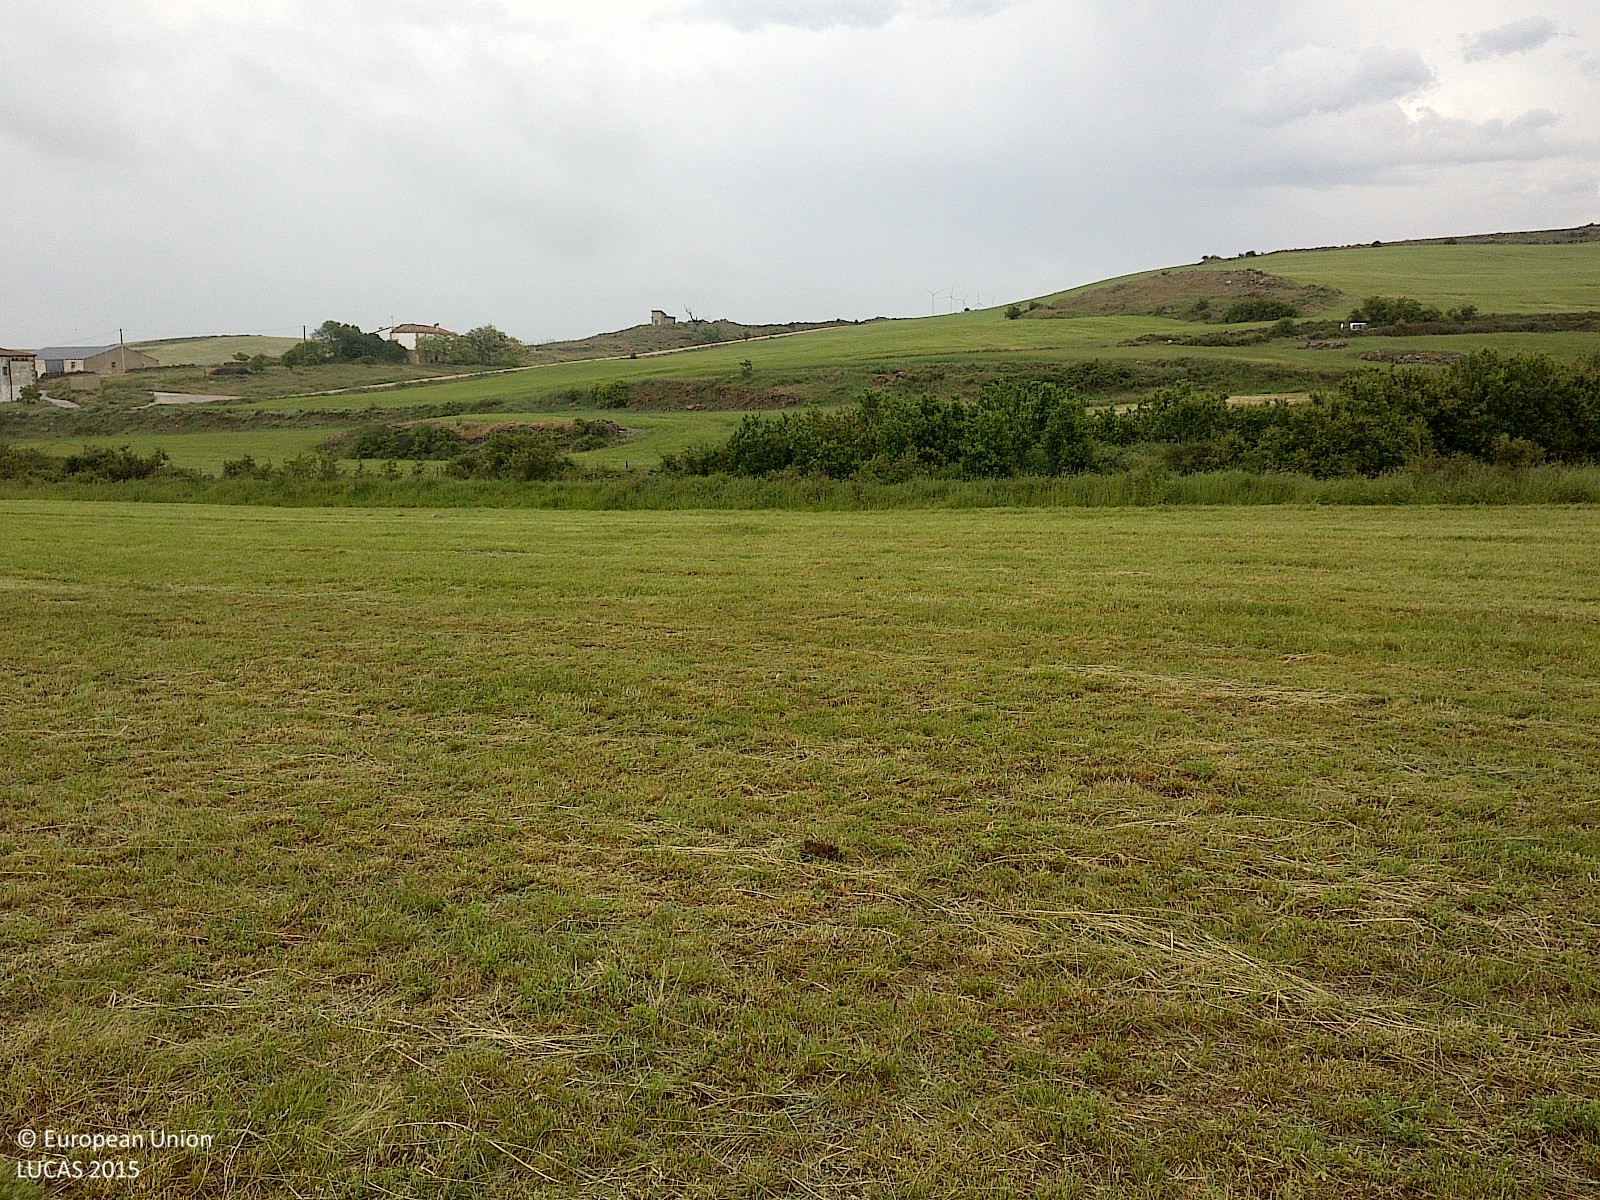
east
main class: Cropland
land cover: Lucerne
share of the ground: > 75 %
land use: Agriculture (excluding fallow land and kitchen gardens)
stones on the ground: < 10 %
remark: Harvested field
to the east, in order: Lucerne; Shrubland with sparse tree cover; Shruby margins; Lucerne; Fences; Barley; Rock outcrops; Barley; Spontaneously vegetated surfaces; Tracks; Grass margins; Barley
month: May
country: ES
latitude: 41.7622
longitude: -2.2440
